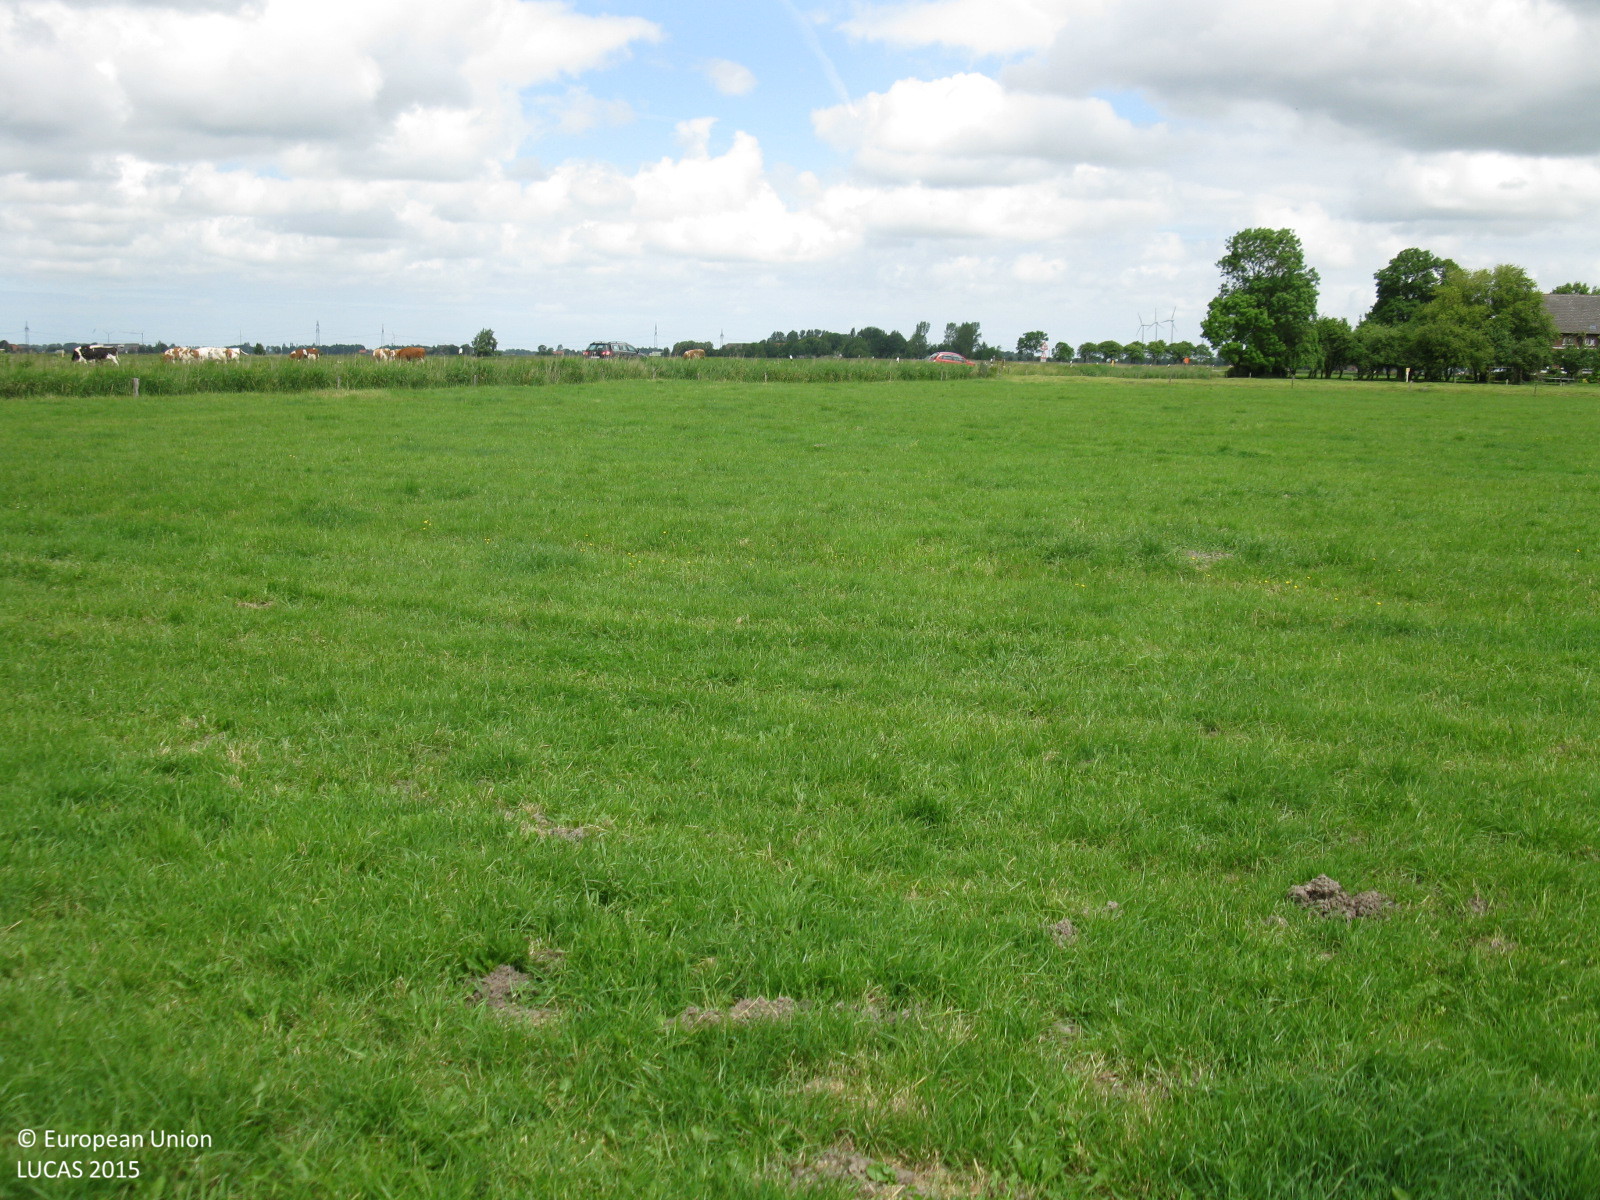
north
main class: Grassland
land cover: Grassland without tree/shrub cover
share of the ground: > 75 %
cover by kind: herbaceous plants 100 %
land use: Agriculture (excluding fallow land and kitchen gardens)
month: June
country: DE
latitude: 53.3368
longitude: 7.3424
